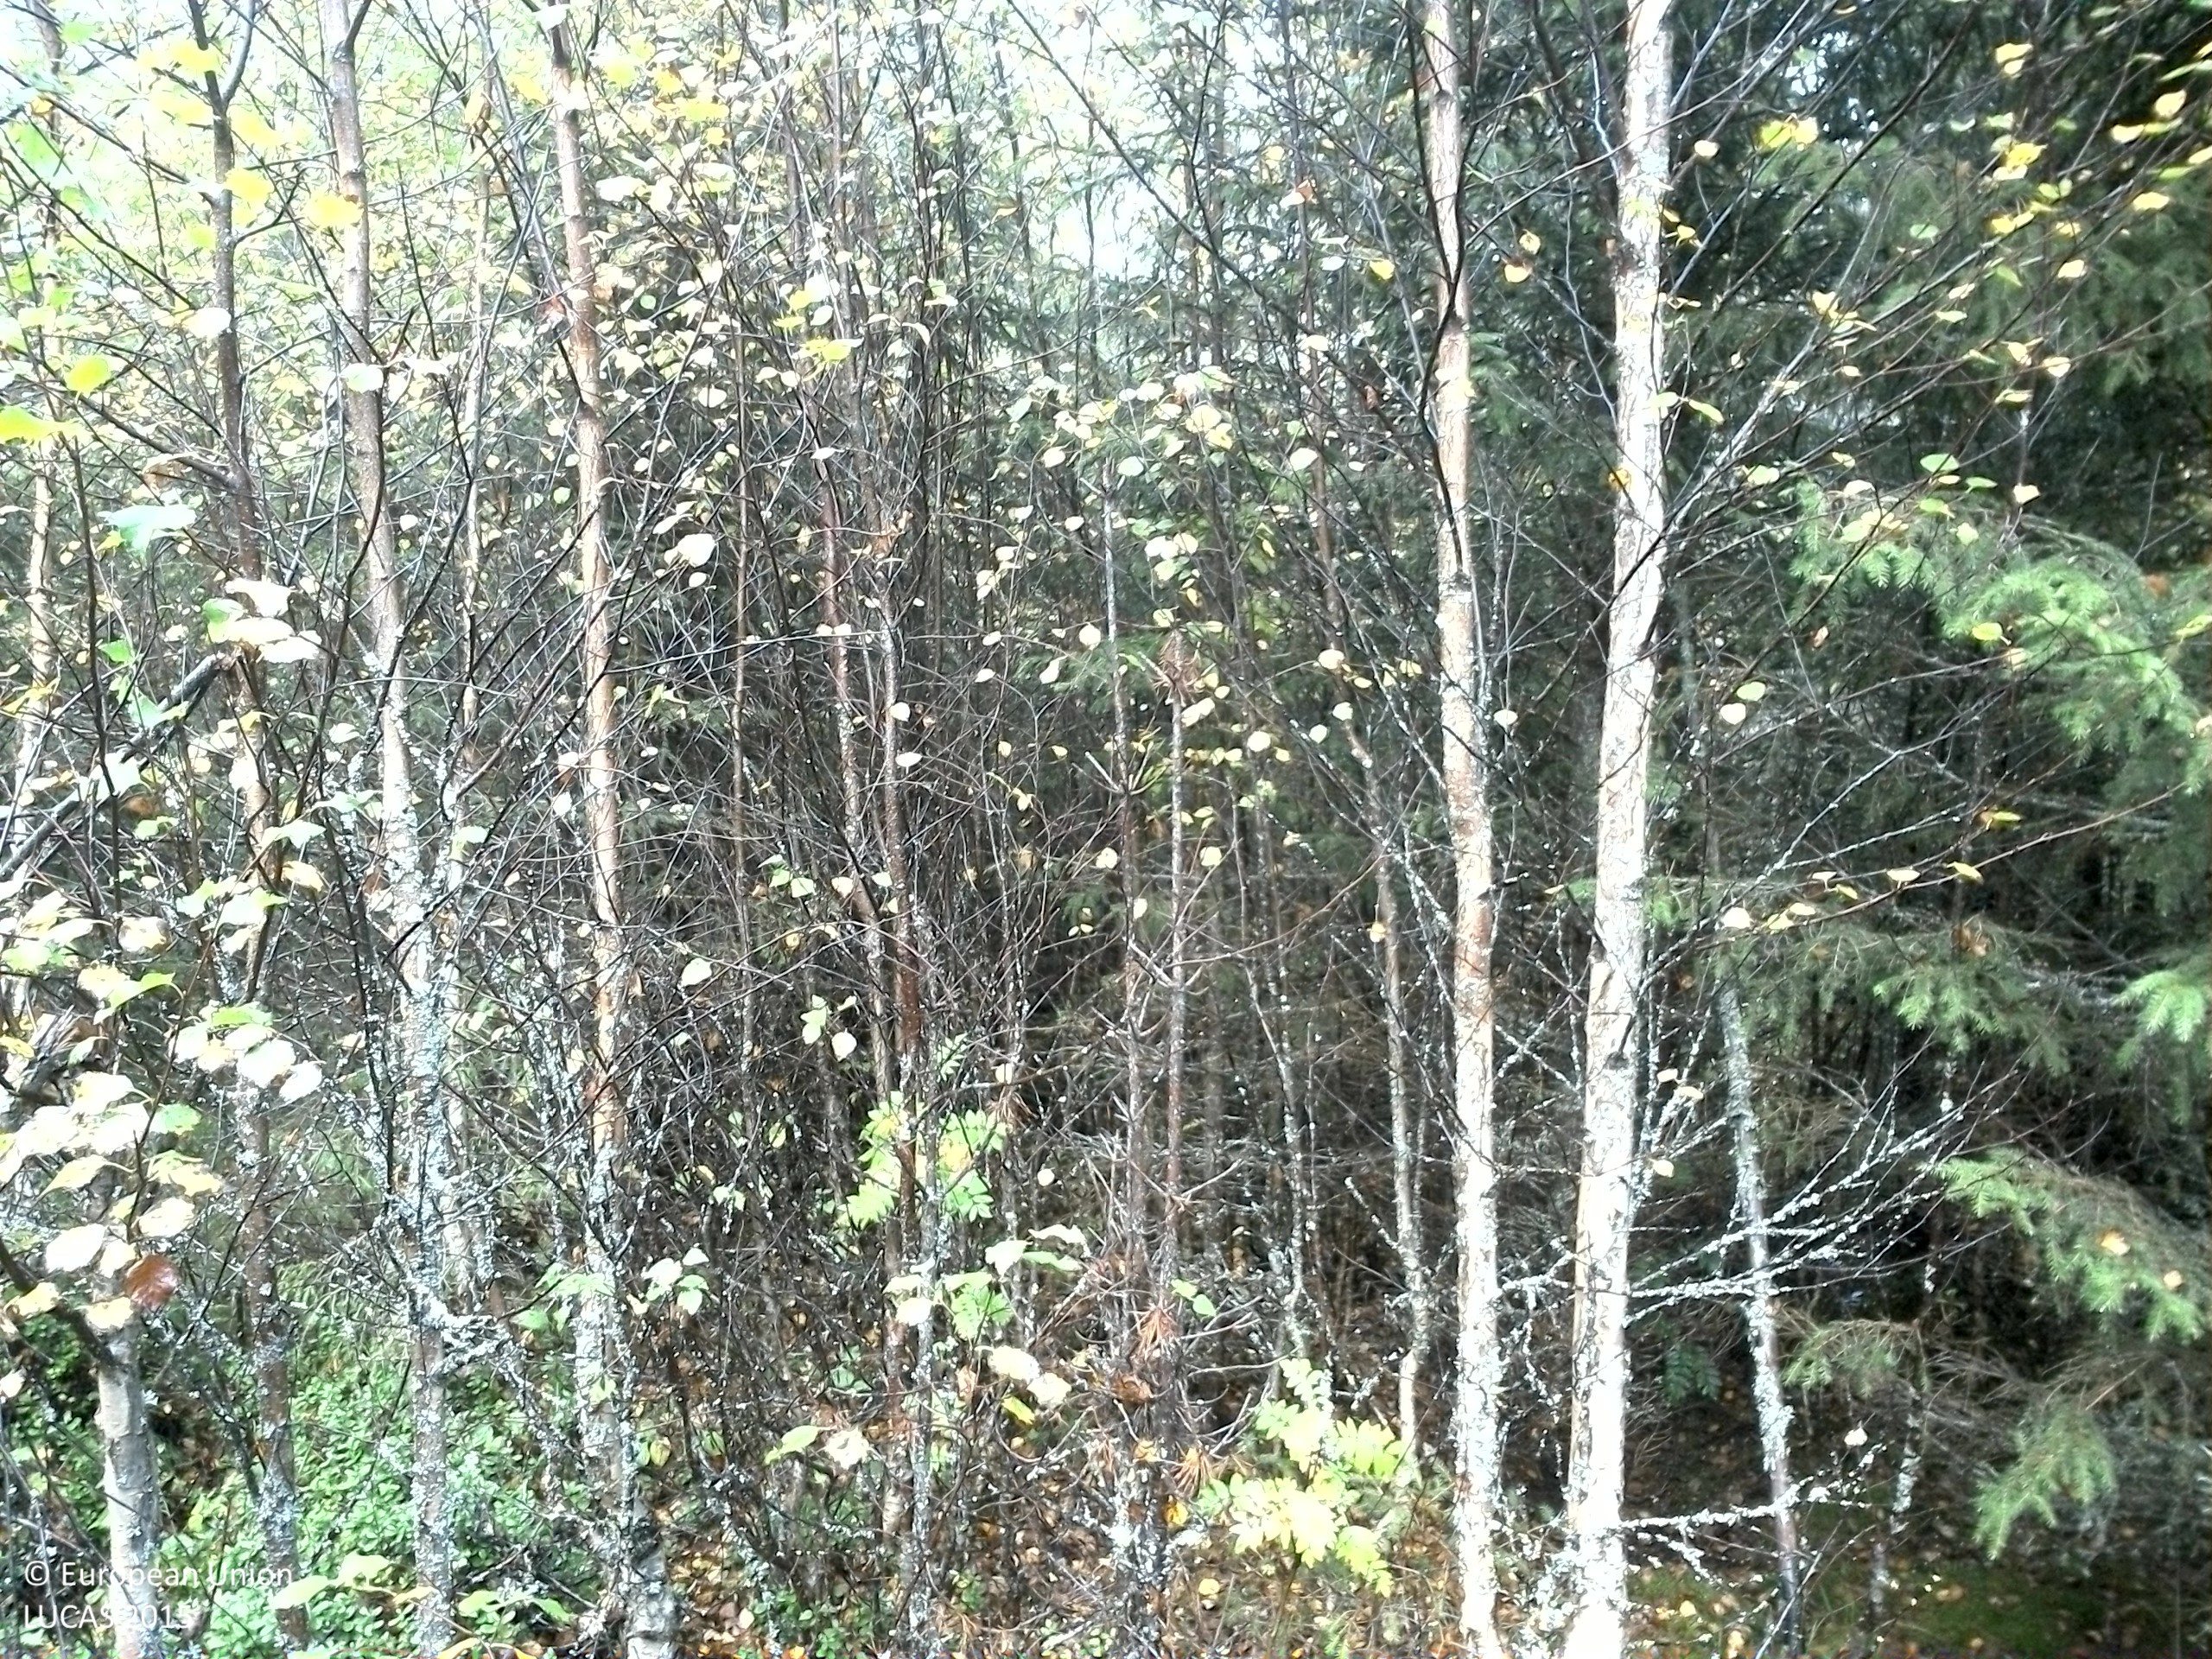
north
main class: Woodland
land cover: Spruce dominated mixed woodland
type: boreal forest
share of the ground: 50 - 75 %
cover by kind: coniferous forest trees 45 %, broadleaved forest trees 25 %, shrubs 15 %, herbaceous plants 15 %
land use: Forestry
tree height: < 5 m
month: September
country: SE
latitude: 61.1753
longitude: 14.9871
